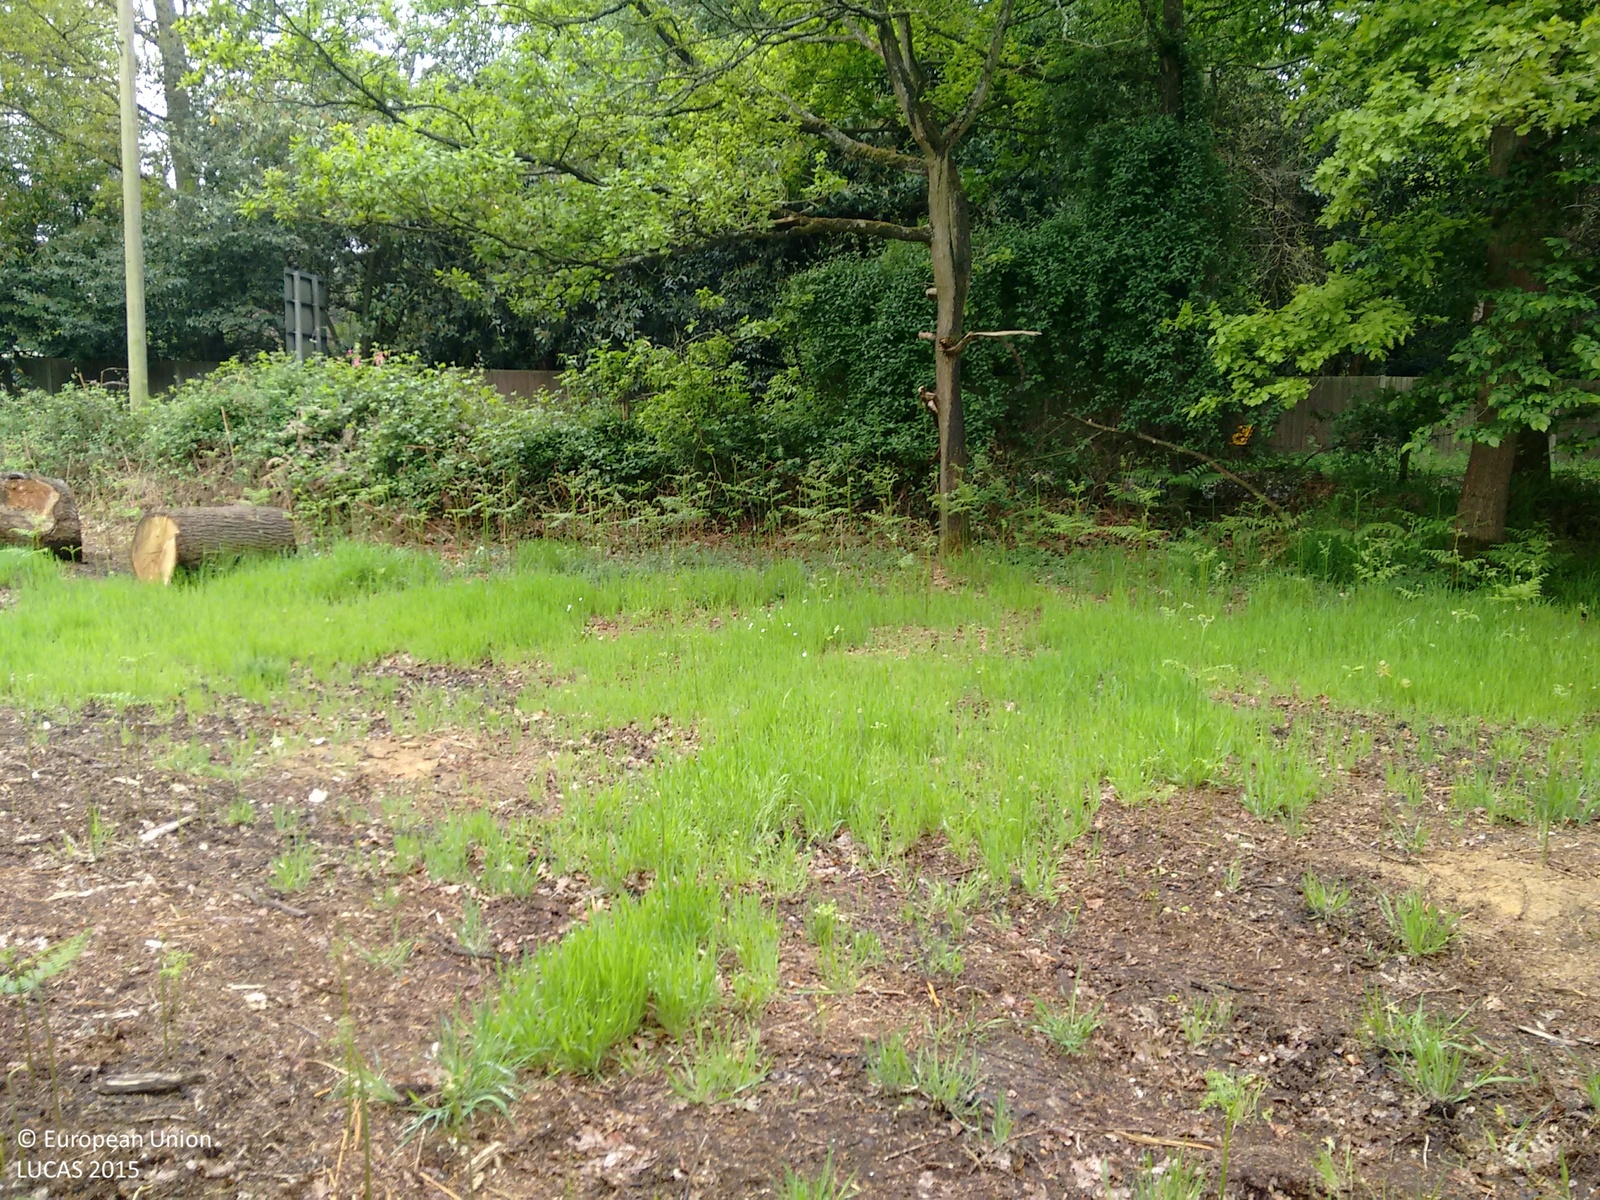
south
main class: Grassland
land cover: Spontaneously vegetated surfaces
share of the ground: 25 - 50 %
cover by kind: herbaceous plants 50 %, unconsolidated bare surface 50 %
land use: Semi-natural and natural areas not in use
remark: Clear cut
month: May
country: GB
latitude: 51.3492
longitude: -0.8833
